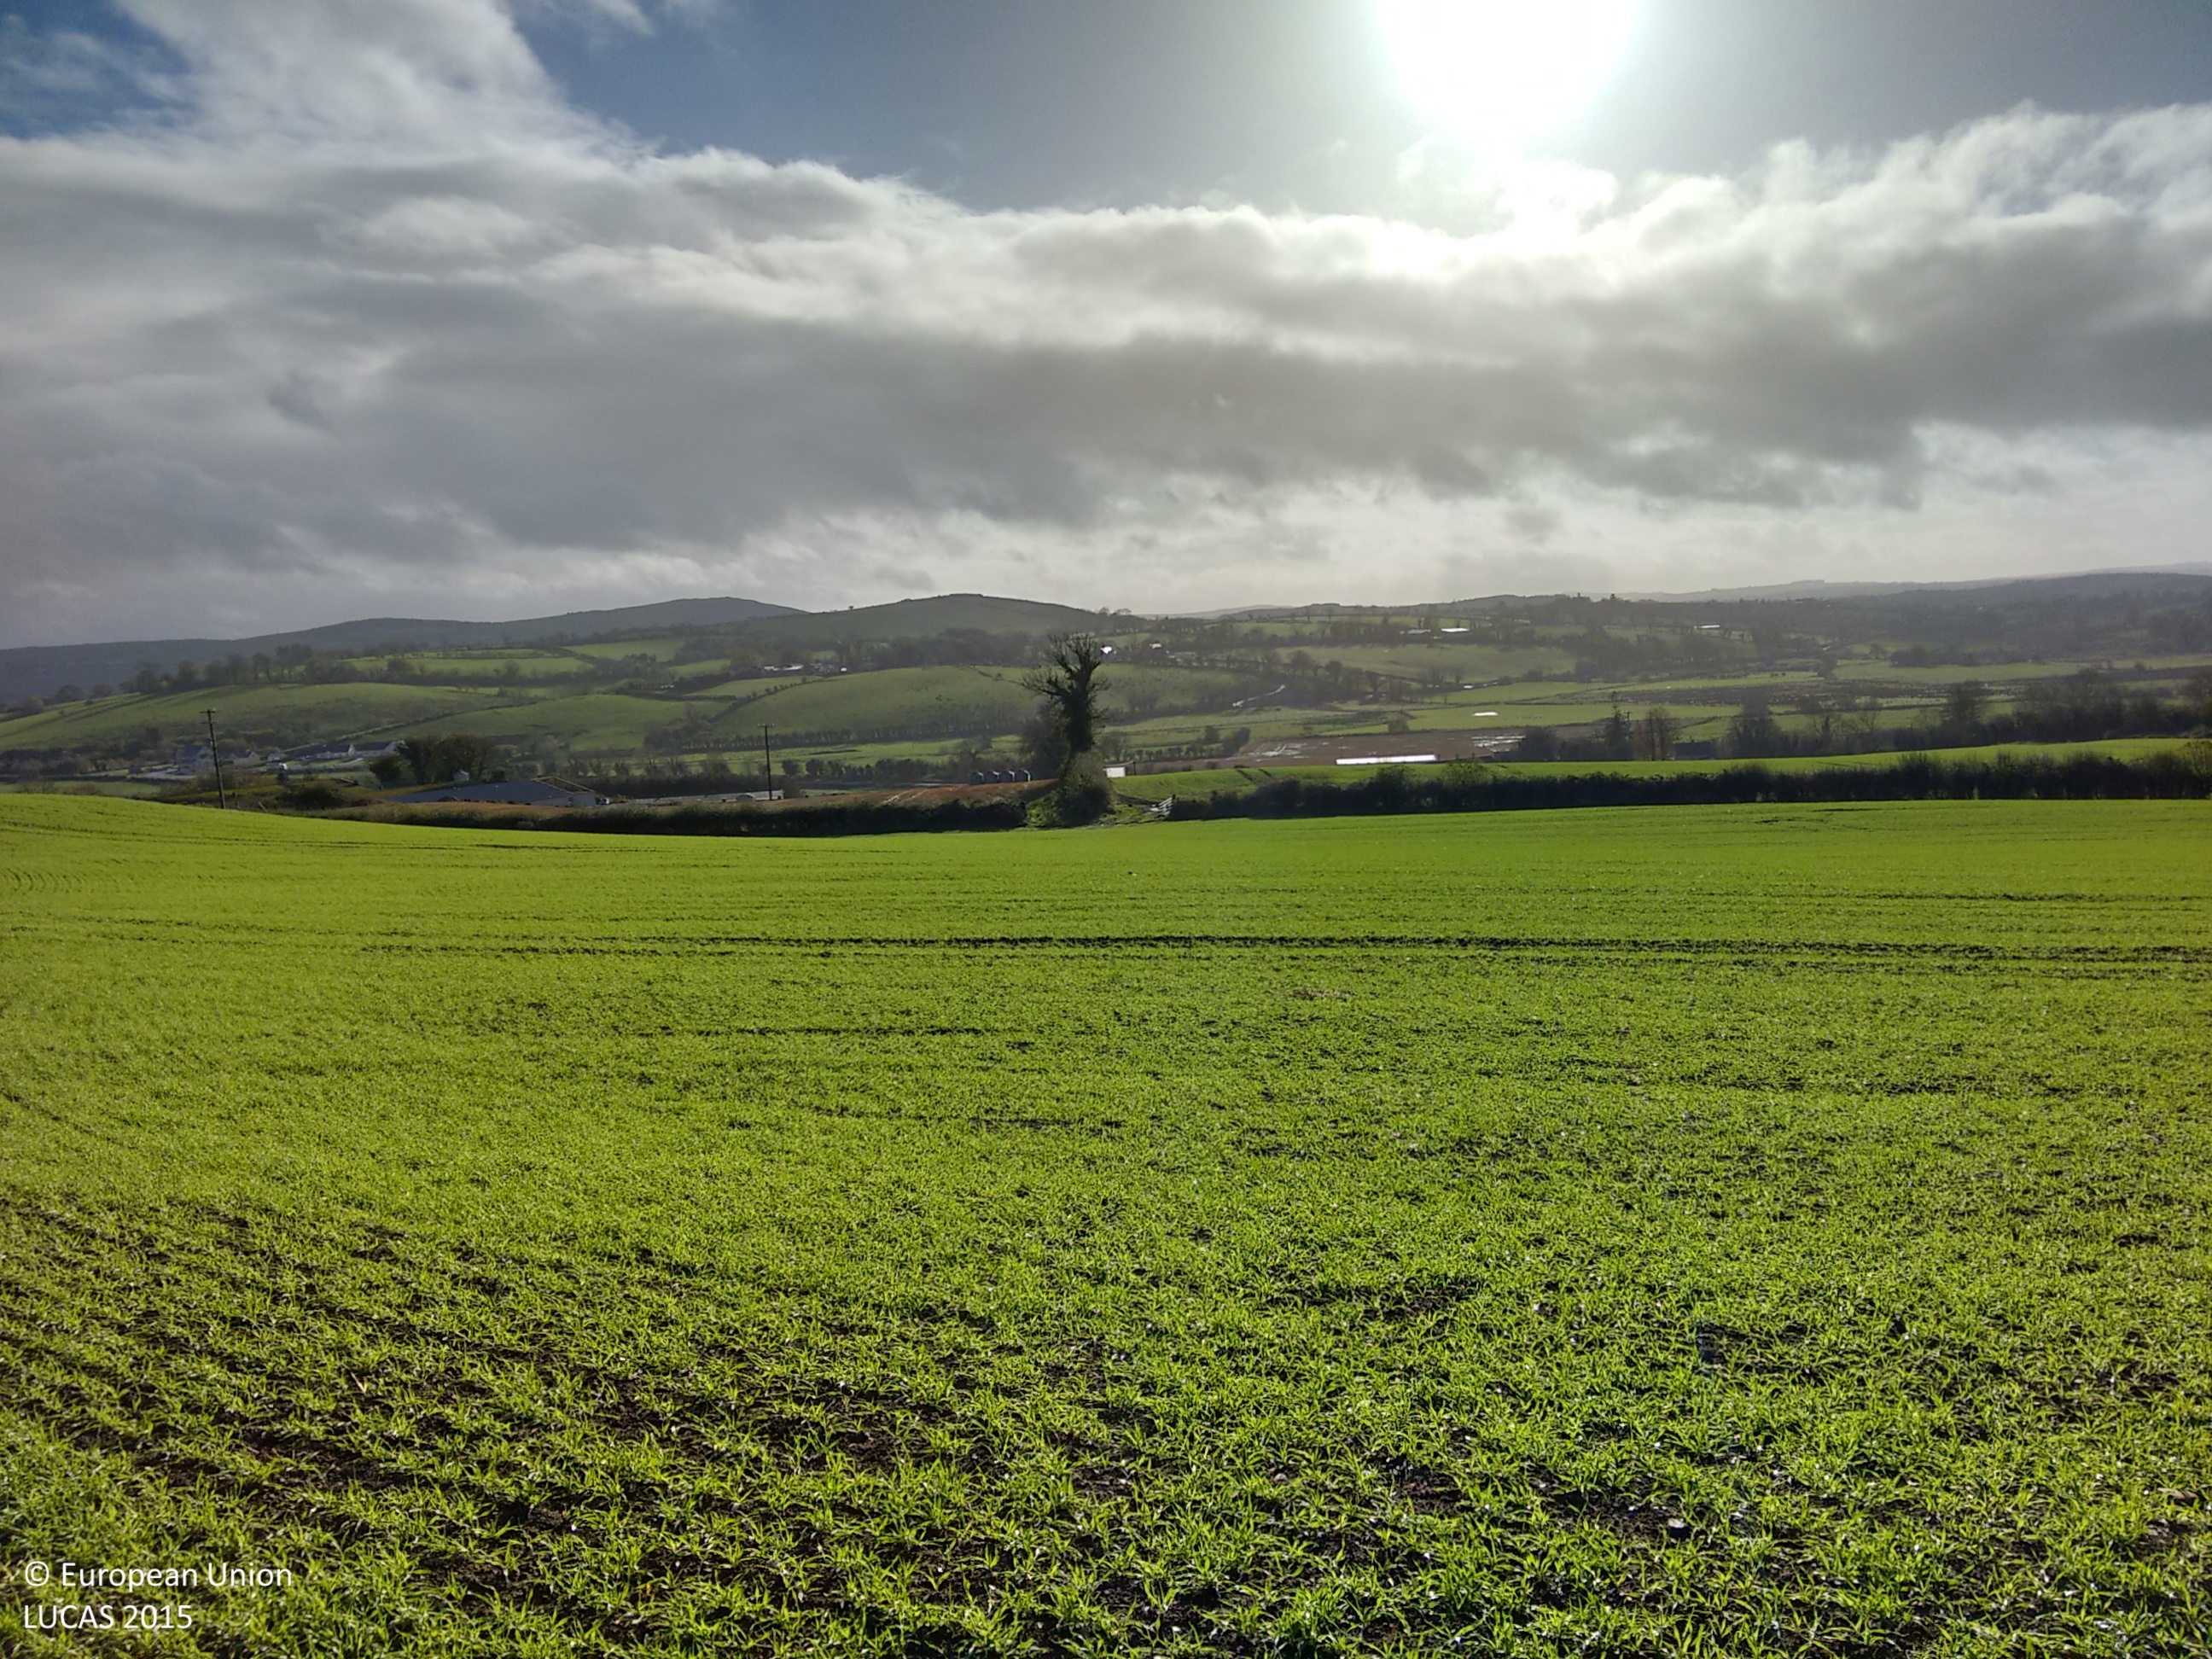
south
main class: Cropland
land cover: Barley
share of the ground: < 10 %
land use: Agriculture (excluding fallow land and kitchen gardens)
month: November
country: IE
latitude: 54.8693
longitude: -7.5621
